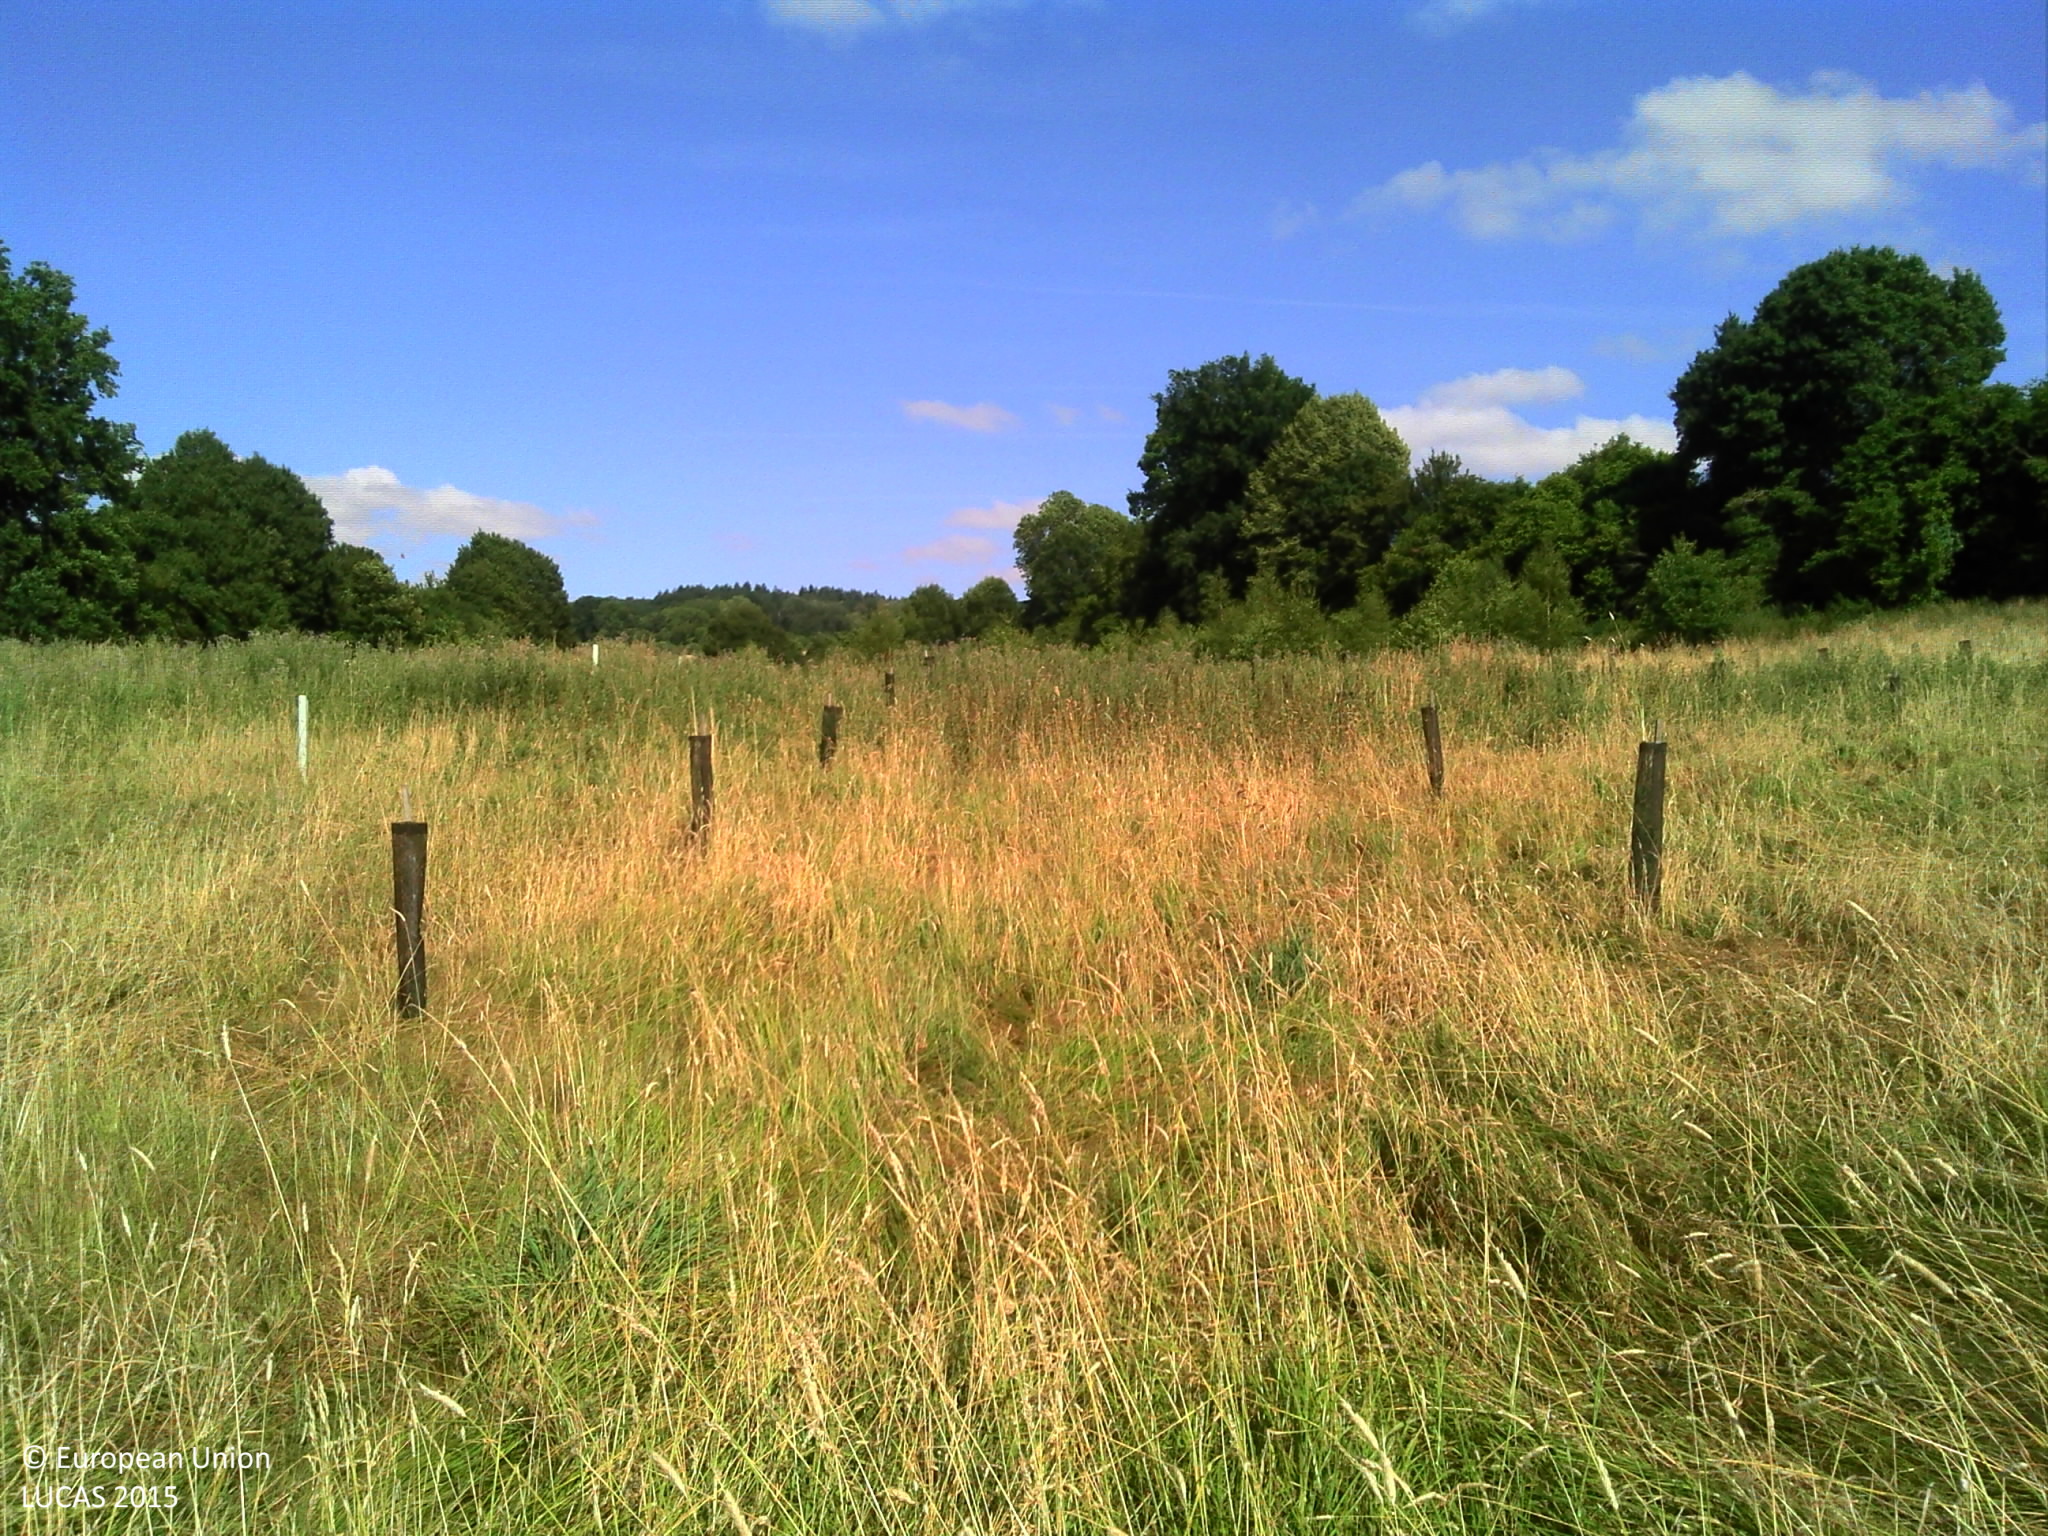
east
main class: Grassland
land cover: Grassland with sparse tree/shrub cover
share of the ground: > 75 %
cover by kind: herbaceous plants 95 %, broadleaved forest trees 5 %
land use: Agriculture (excluding fallow land and kitchen gardens)
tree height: > 5 m
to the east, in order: Grassland with sparse tree/shrub cover; Fences; Broadleaved woodland; Fences; Barley
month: July
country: FR
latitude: 48.2596
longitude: 0.8596
